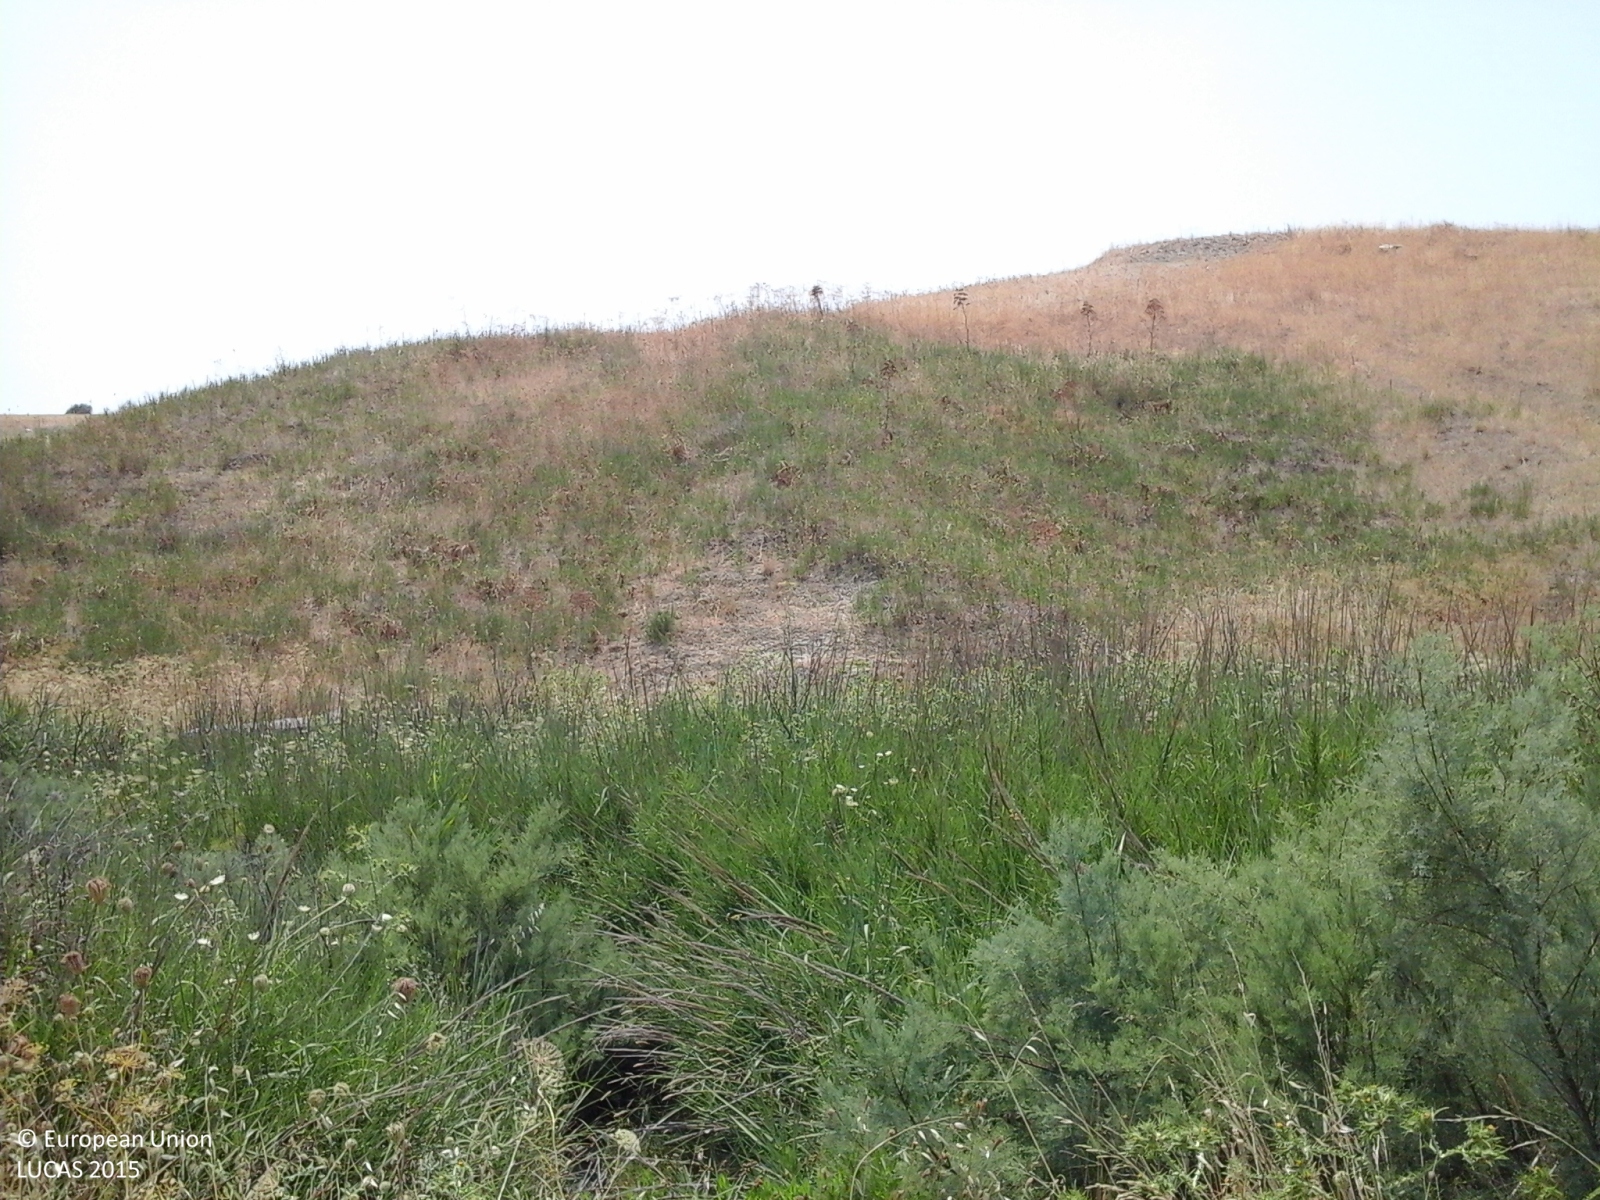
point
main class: Grassland
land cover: Grassland without tree/shrub cover
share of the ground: > 75 %
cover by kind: herbaceous plants 100 %
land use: Semi-natural and natural areas not in use
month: July
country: IT
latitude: 37.3381
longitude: 13.9540
